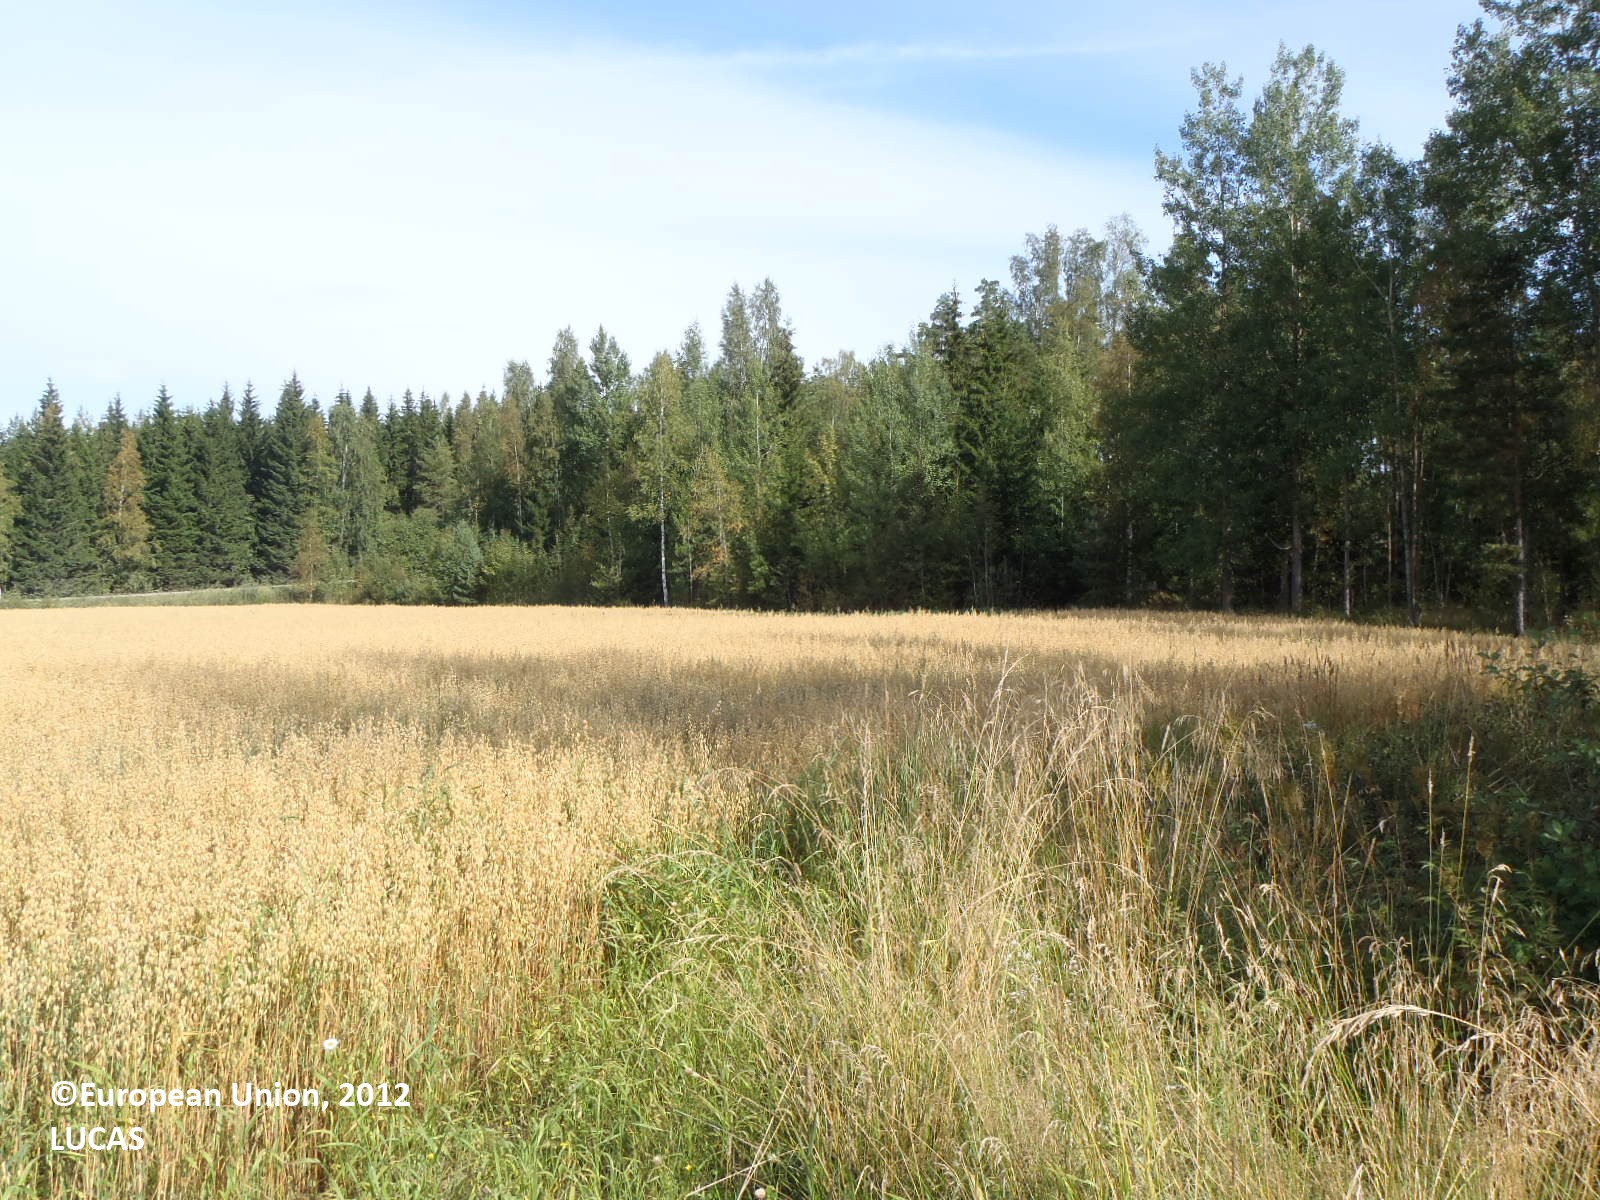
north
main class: Cropland
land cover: Oats
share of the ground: > 75 %
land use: Agriculture (excluding fallow land and kitchen gardens)
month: August
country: FI
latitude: 60.7070
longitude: 22.6216
